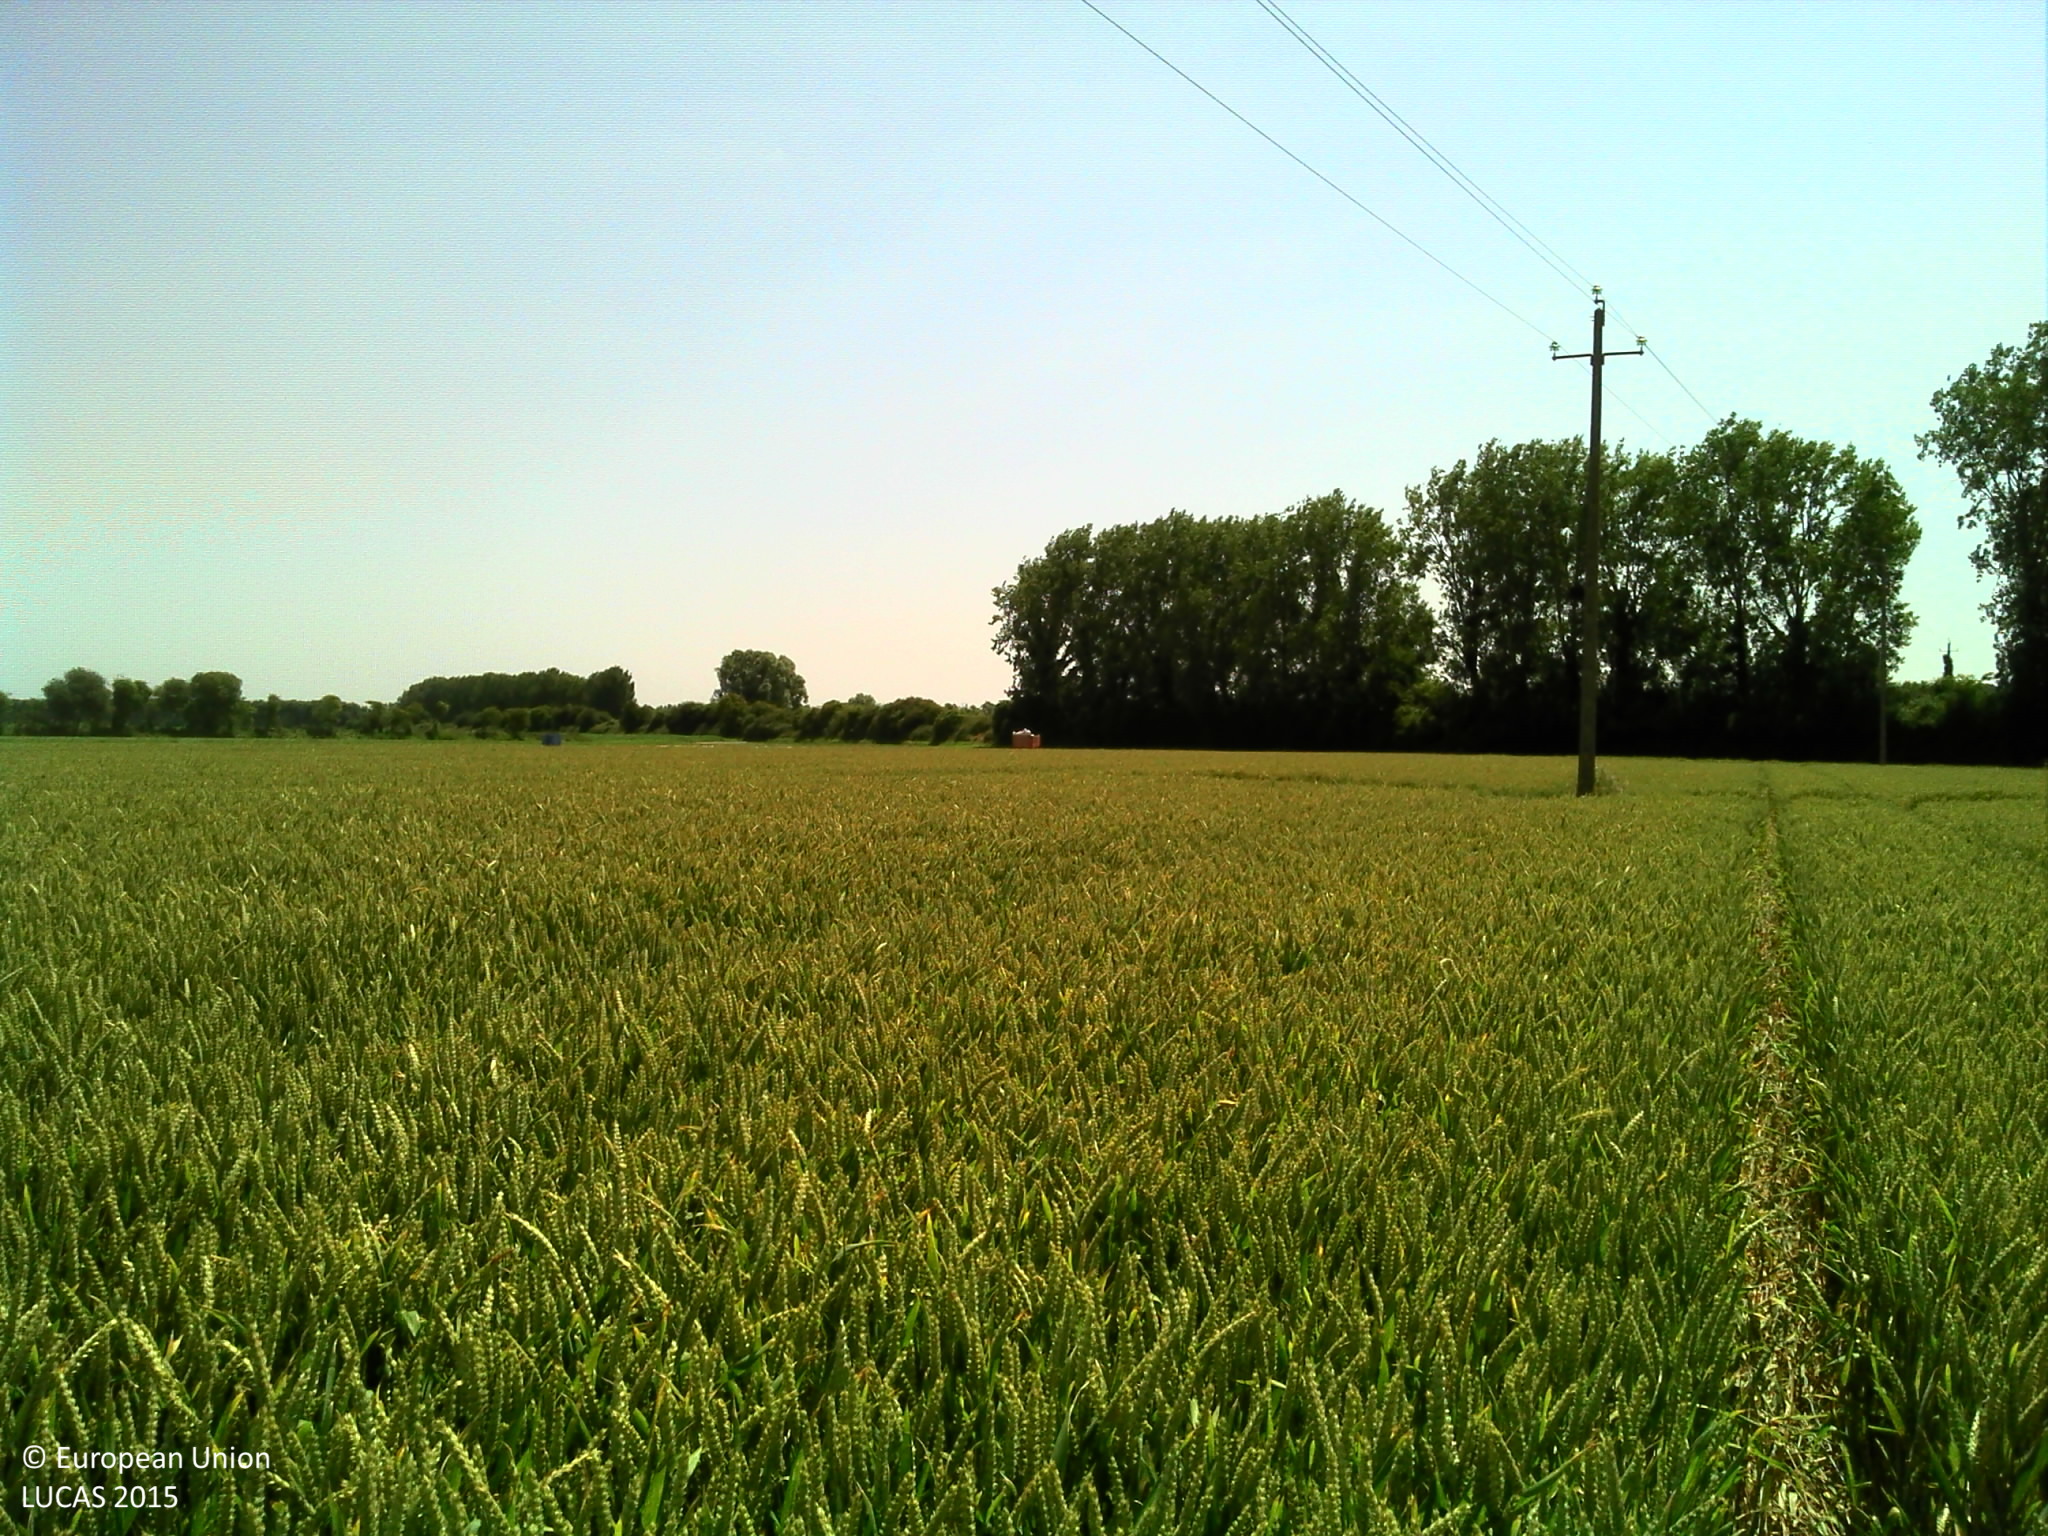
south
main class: Cropland
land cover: Common wheat
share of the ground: > 75 %
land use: Agriculture (excluding fallow land and kitchen gardens)
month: June
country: FR
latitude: 48.5946
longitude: -1.5597
